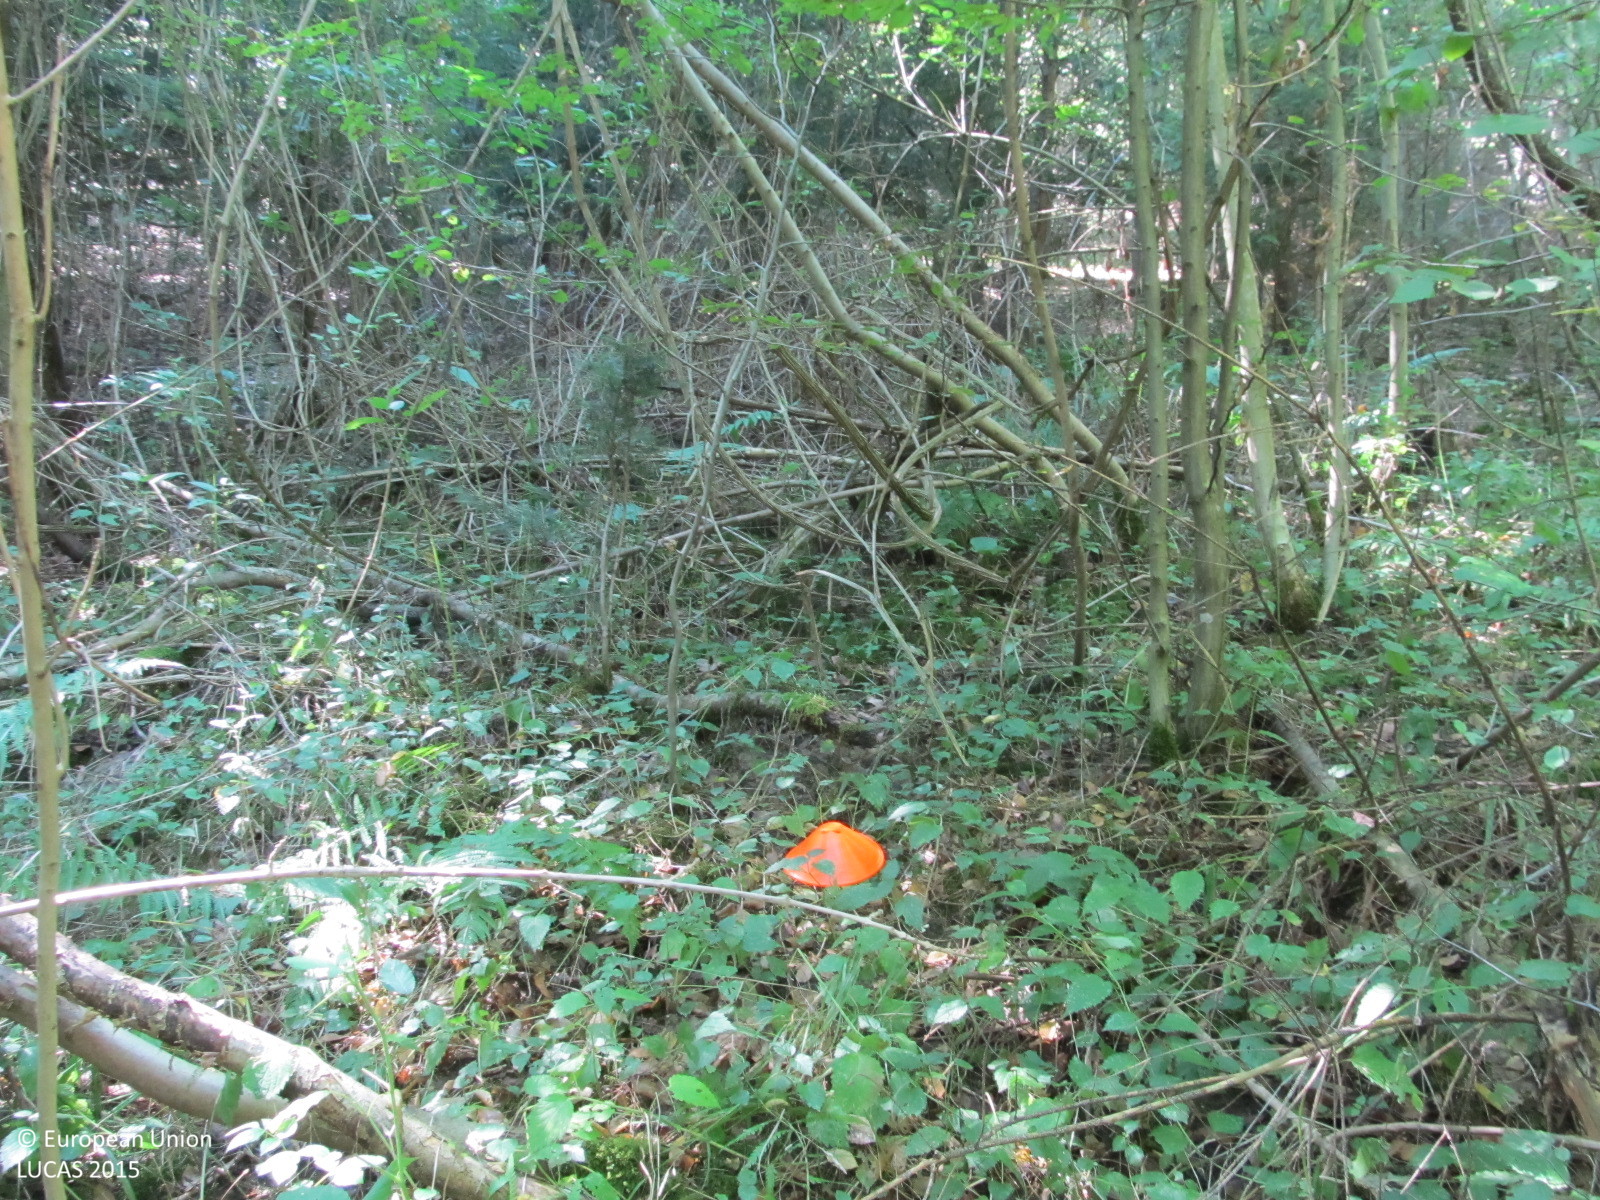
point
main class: Woodland
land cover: Other mixed woodland
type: hemiboreal forest and nemoral coniferous forest and mixed broadleaved-coniferous forest
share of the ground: > 75 %
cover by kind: broadleaved forest trees 55 %, coniferous forest trees 25 %, shrubs 10 %, unconsolidated bare surface 10 %
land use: Forestry
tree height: > 5 m
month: August
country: AT
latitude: 48.5655
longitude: 15.6541
